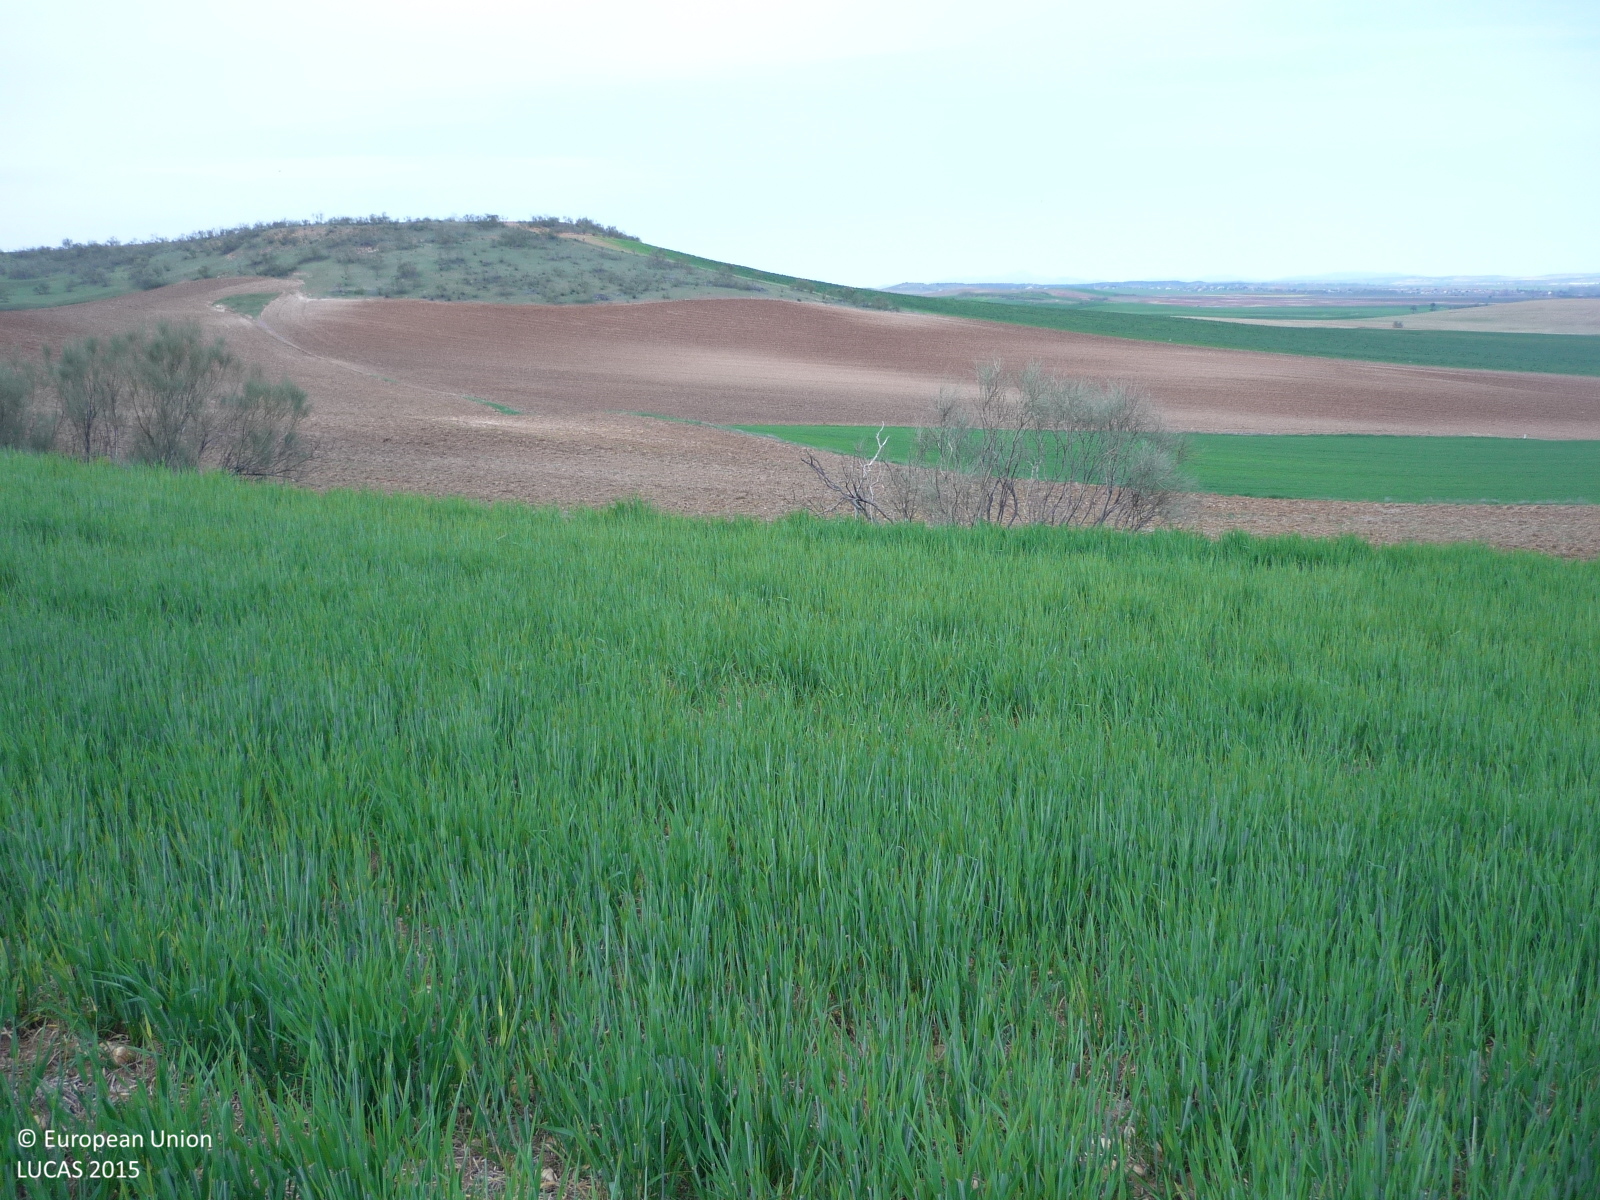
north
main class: Cropland
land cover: Barley
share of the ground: > 75 %
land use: Agriculture (excluding fallow land and kitchen gardens)
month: April
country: ES
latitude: 40.5645
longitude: -3.4416
